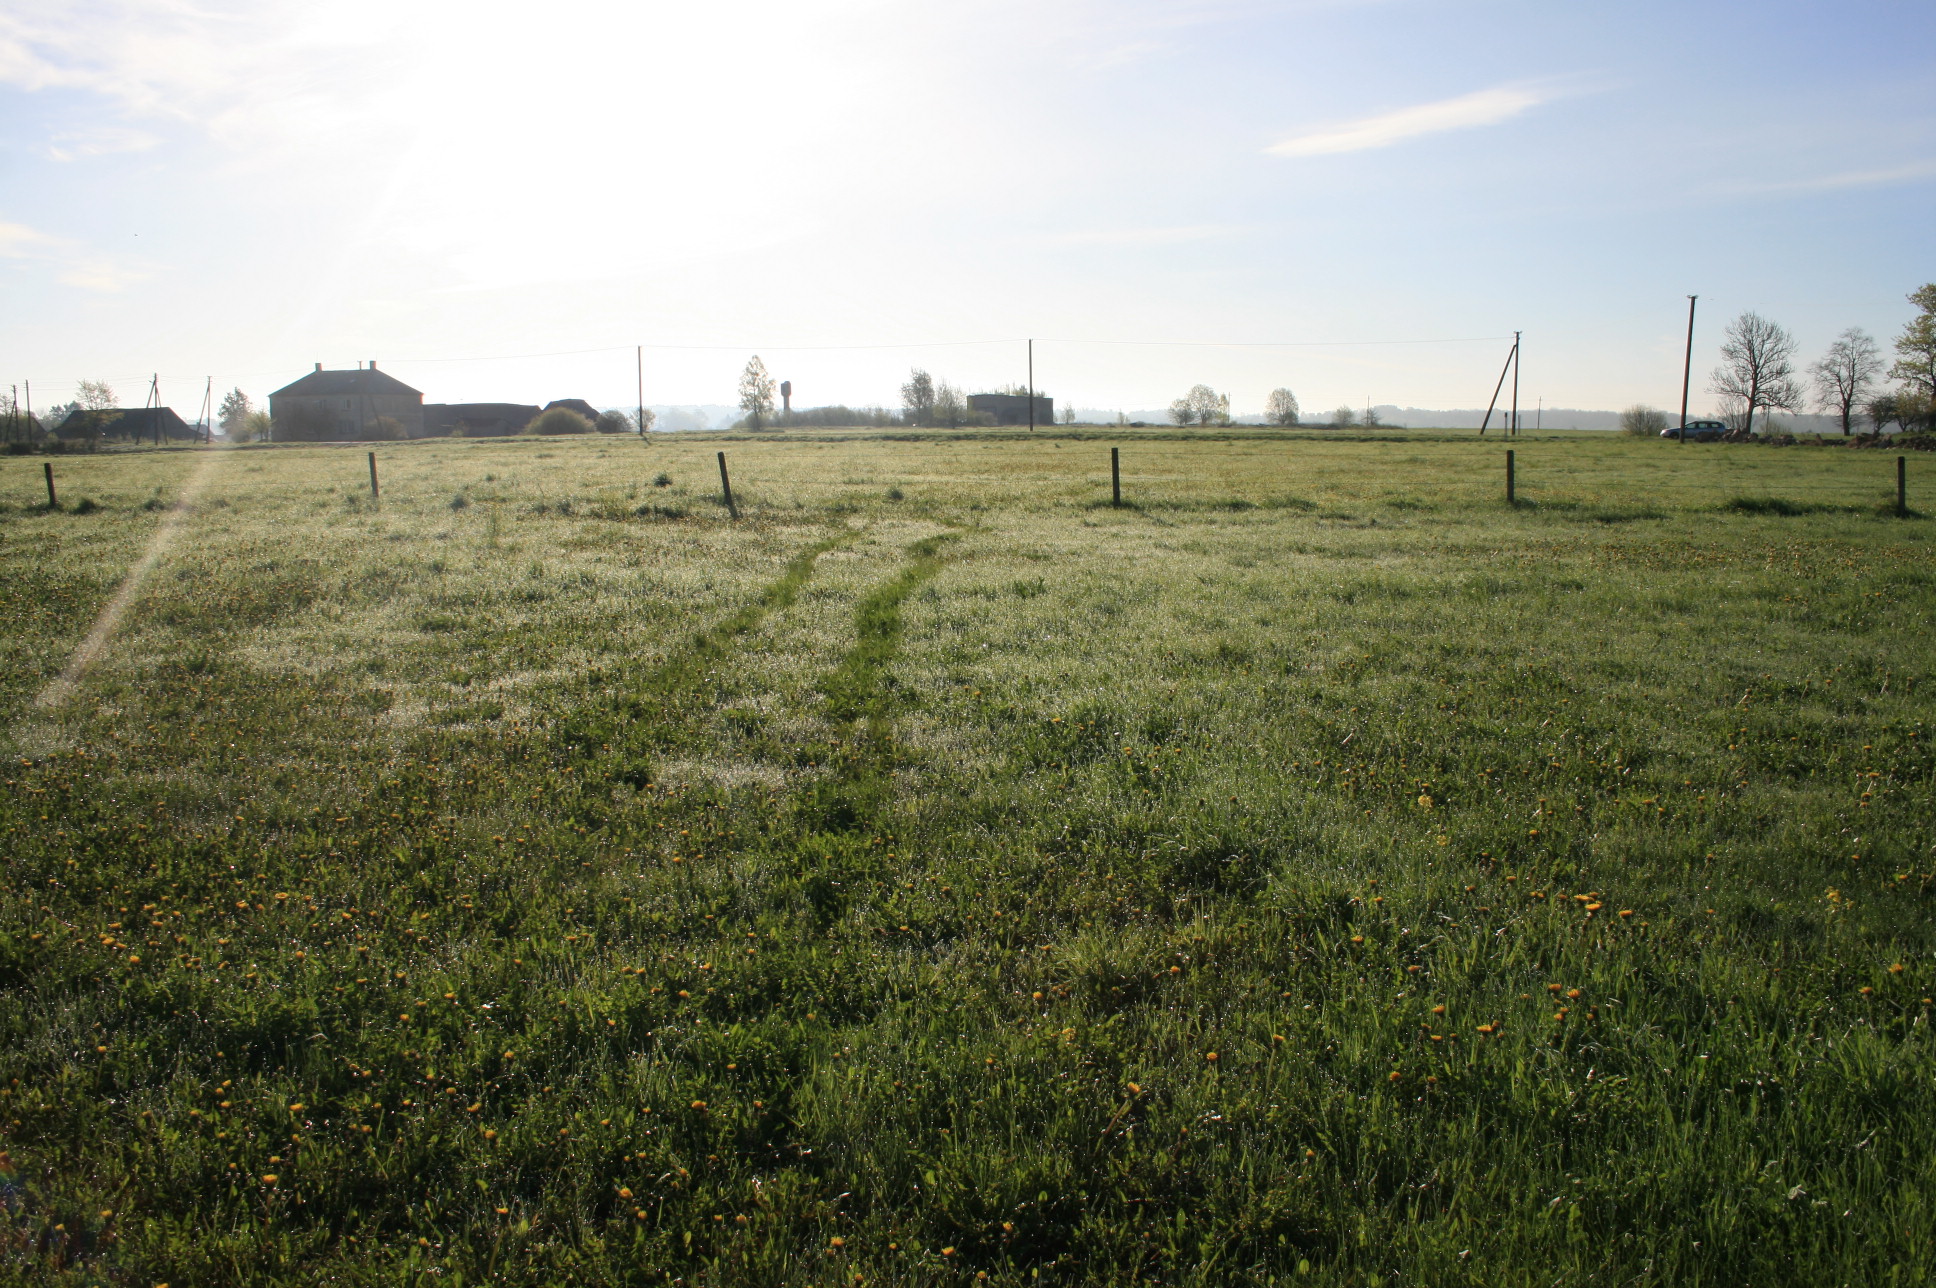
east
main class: Grassland
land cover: Grassland without tree/shrub cover
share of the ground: > 75 %
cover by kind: herbaceous plants 100 %
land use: Agriculture (excluding fallow land and kitchen gardens)
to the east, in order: Grassland without tree/shrub cover; Fences; Grassland without tree/shrub cover; Grass margins; Paved roads, cycling and walking lanes; Grass margins; Electric lines; Grassland without tree/shrub cover
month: May
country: LT
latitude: 56.1399
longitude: 21.5181
